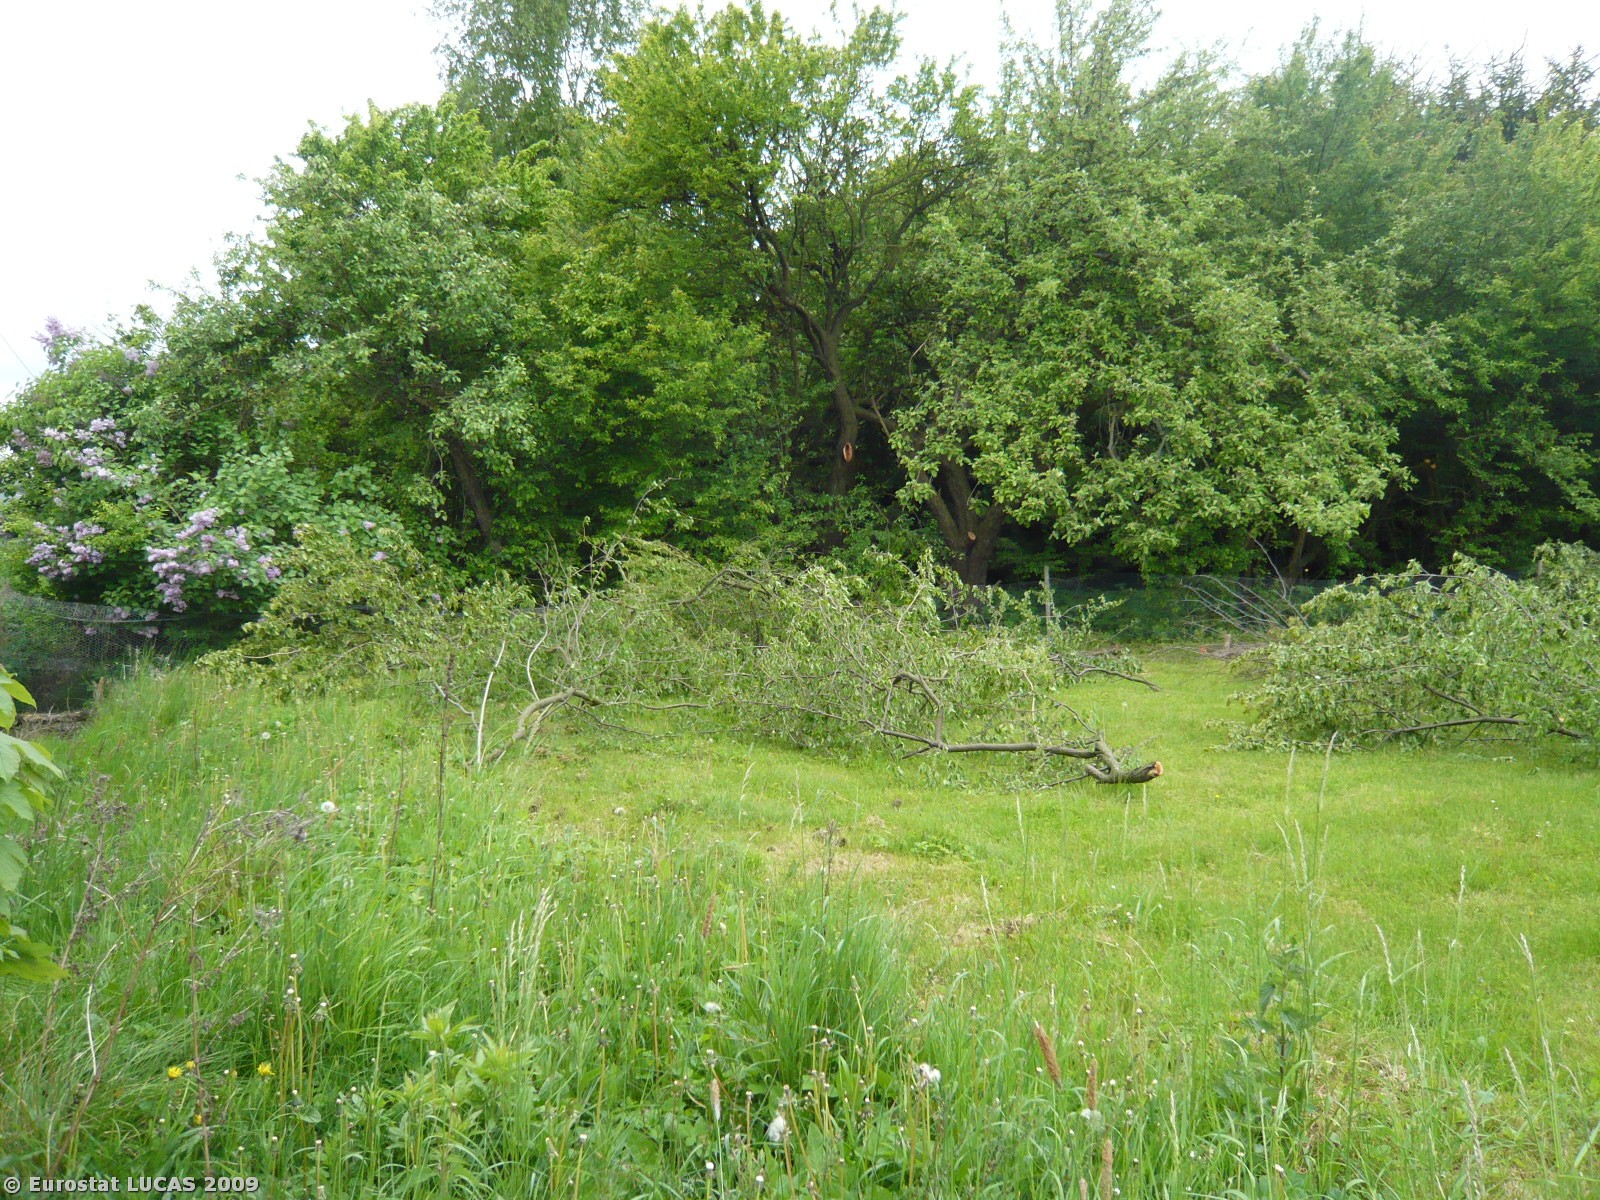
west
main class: Grassland
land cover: Grassland without tree/shrub cover
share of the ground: > 75 %
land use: Residential
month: May
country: DK
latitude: 55.4399
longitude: 11.6583
